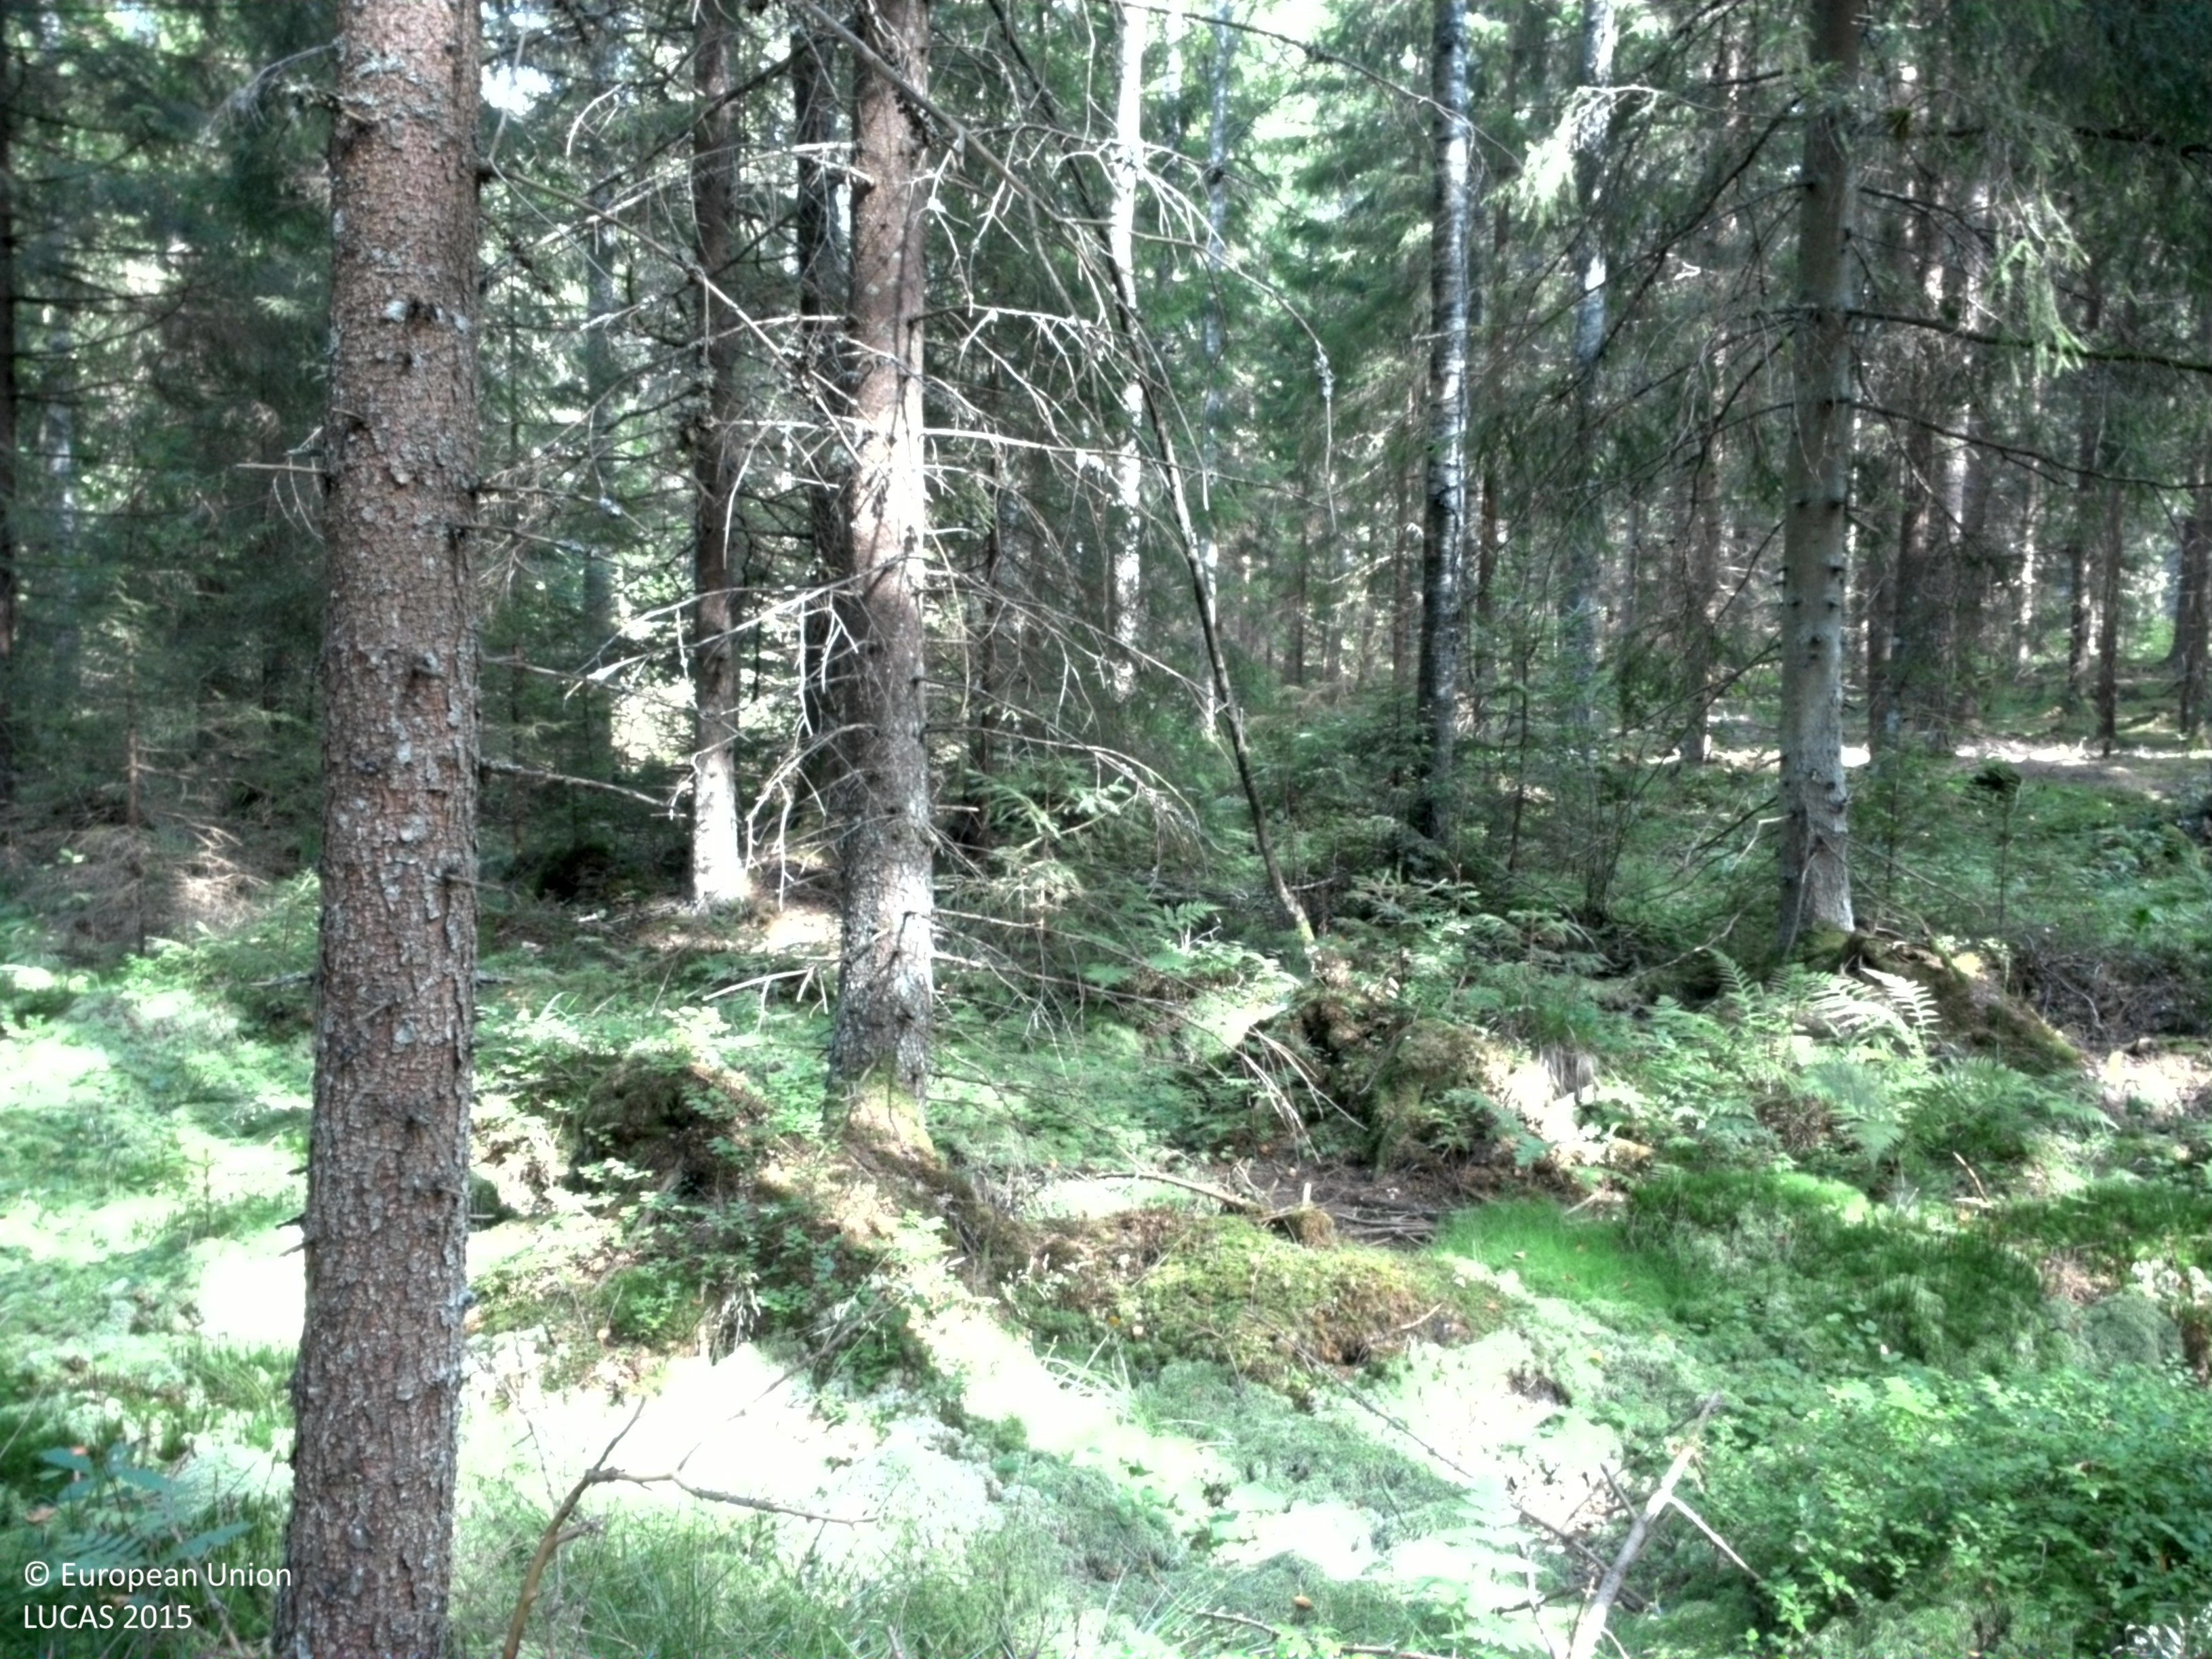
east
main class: Woodland
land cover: Spruce dominated coniferous woodland
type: boreal forest
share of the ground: 50 - 75 %
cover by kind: coniferous forest trees 55 %, lichens and mosses 35 %, shrubs 5 %, herbaceous plants 5 %
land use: Forestry
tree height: > 5 m
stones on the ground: < 10 %
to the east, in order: Spruce dominated coniferous woodland; Ditches and canals; Grass margins; Paved roads, cycling and walking lanes; Grass margins; Ditches and canals; Grassland with sparse tree/shrub cover; Tracks; Grassland with sparse tree/shrub cover; Pine dominated coniferous woodland; Spruce dominated coniferous woodland
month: August
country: SE
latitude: 58.7888
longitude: 14.0588
